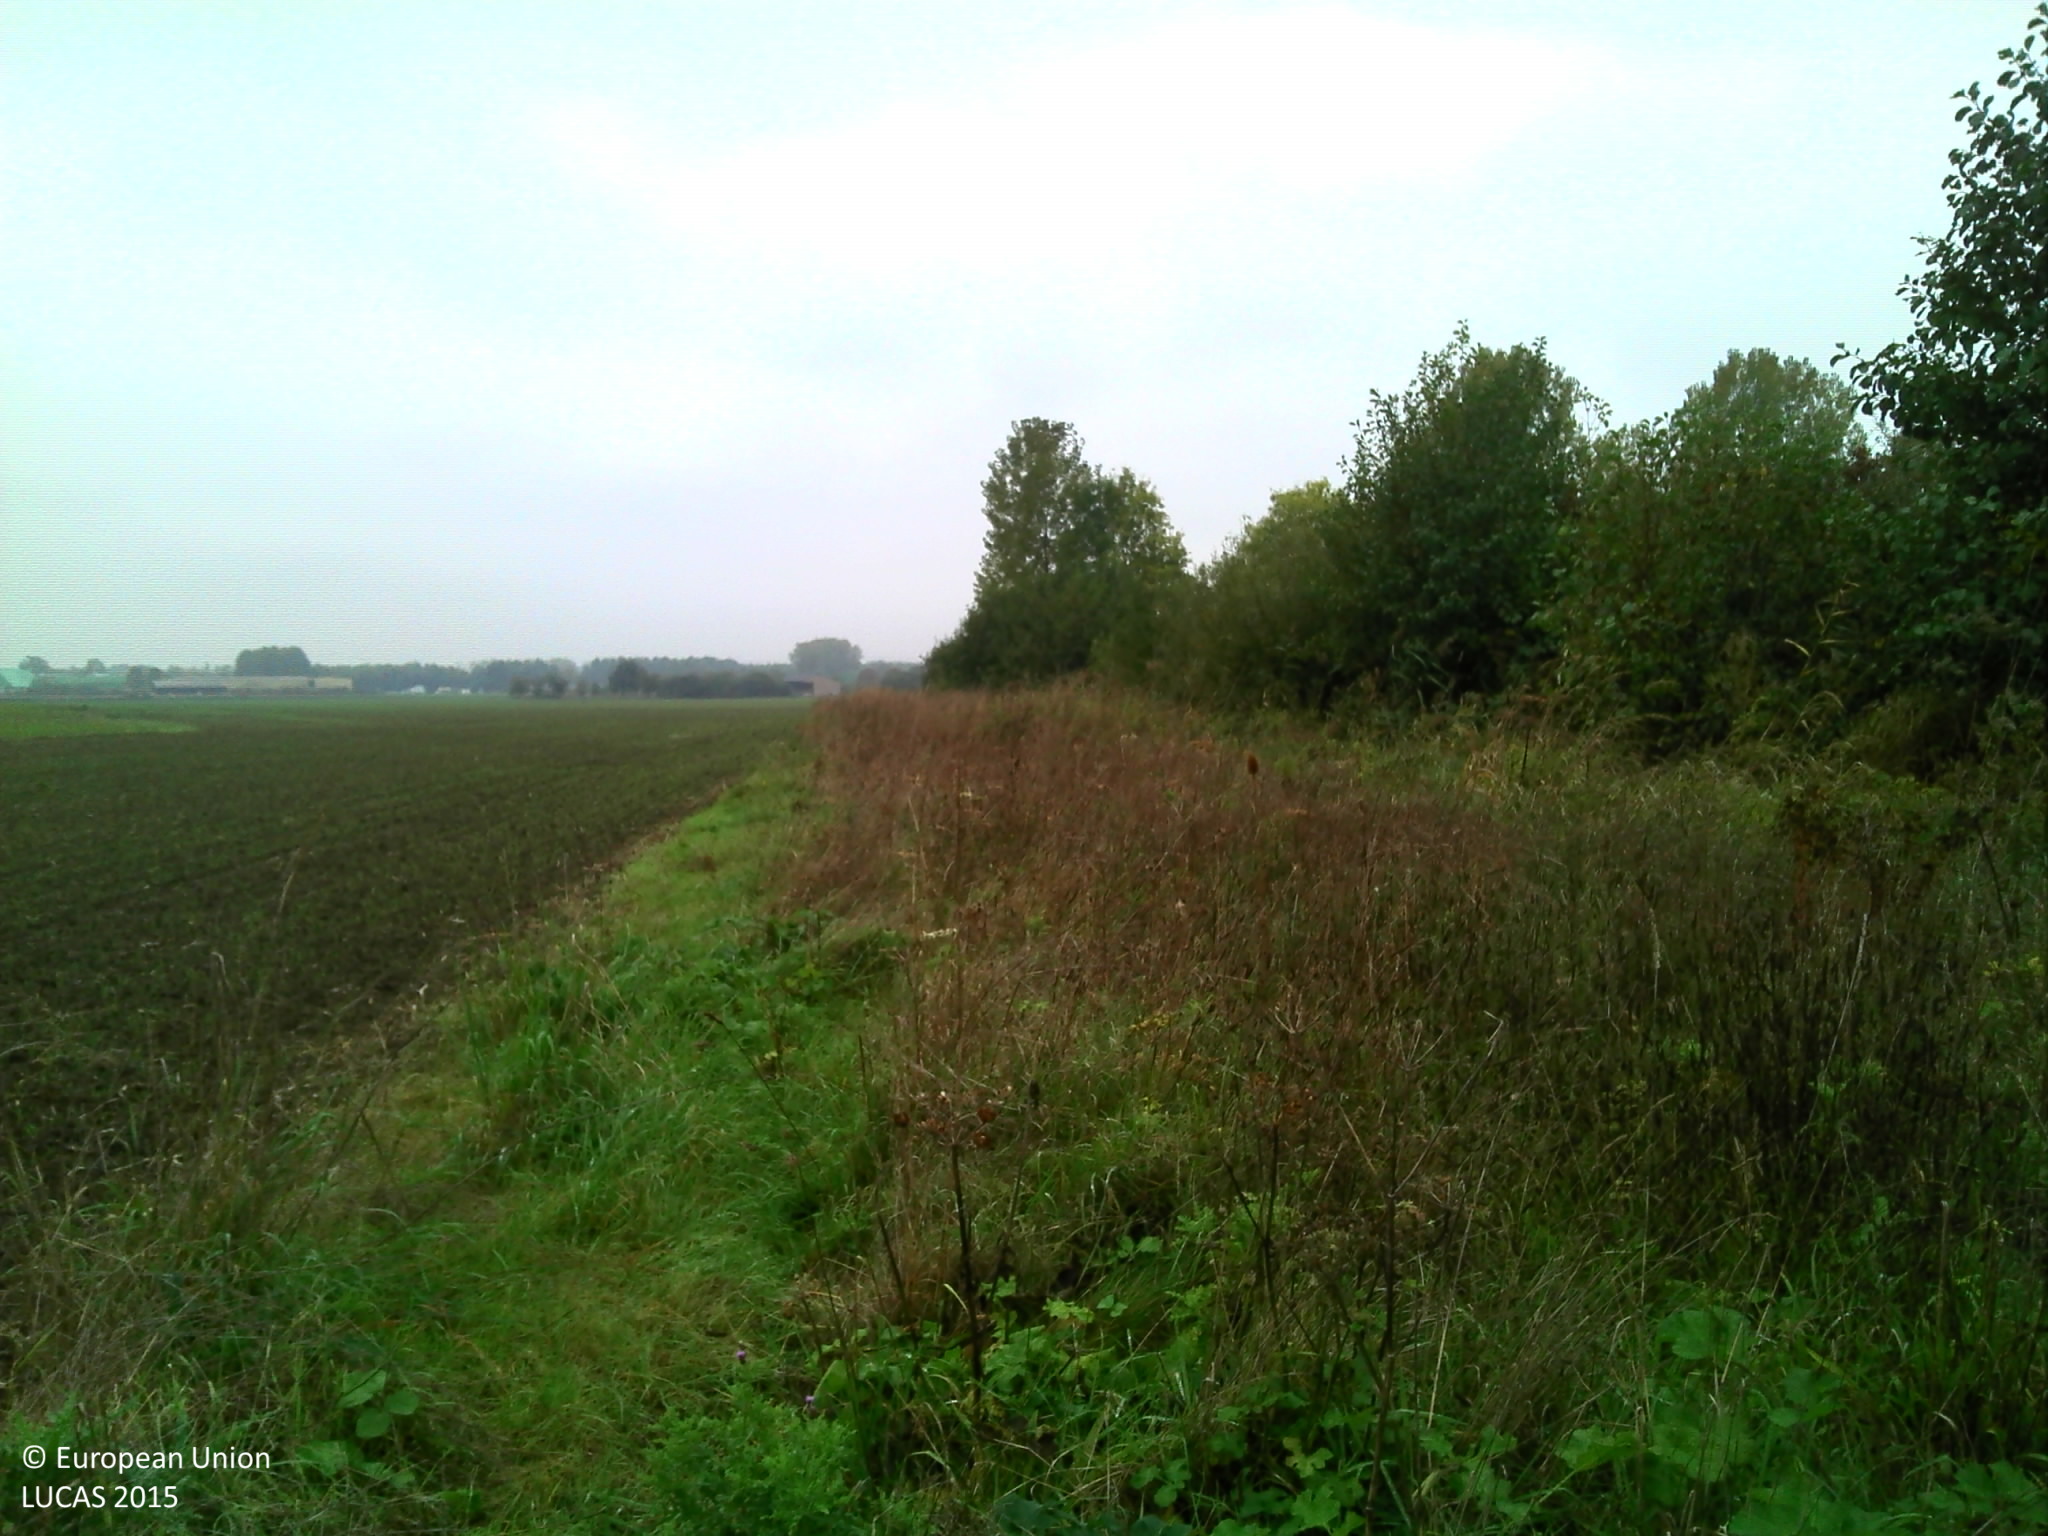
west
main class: Grassland
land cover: Spontaneously vegetated surfaces
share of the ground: > 75 %
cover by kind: herbaceous plants 100 %
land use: Agriculture (excluding fallow land and kitchen gardens)
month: June
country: FR
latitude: 49.5367
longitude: 3.6230
